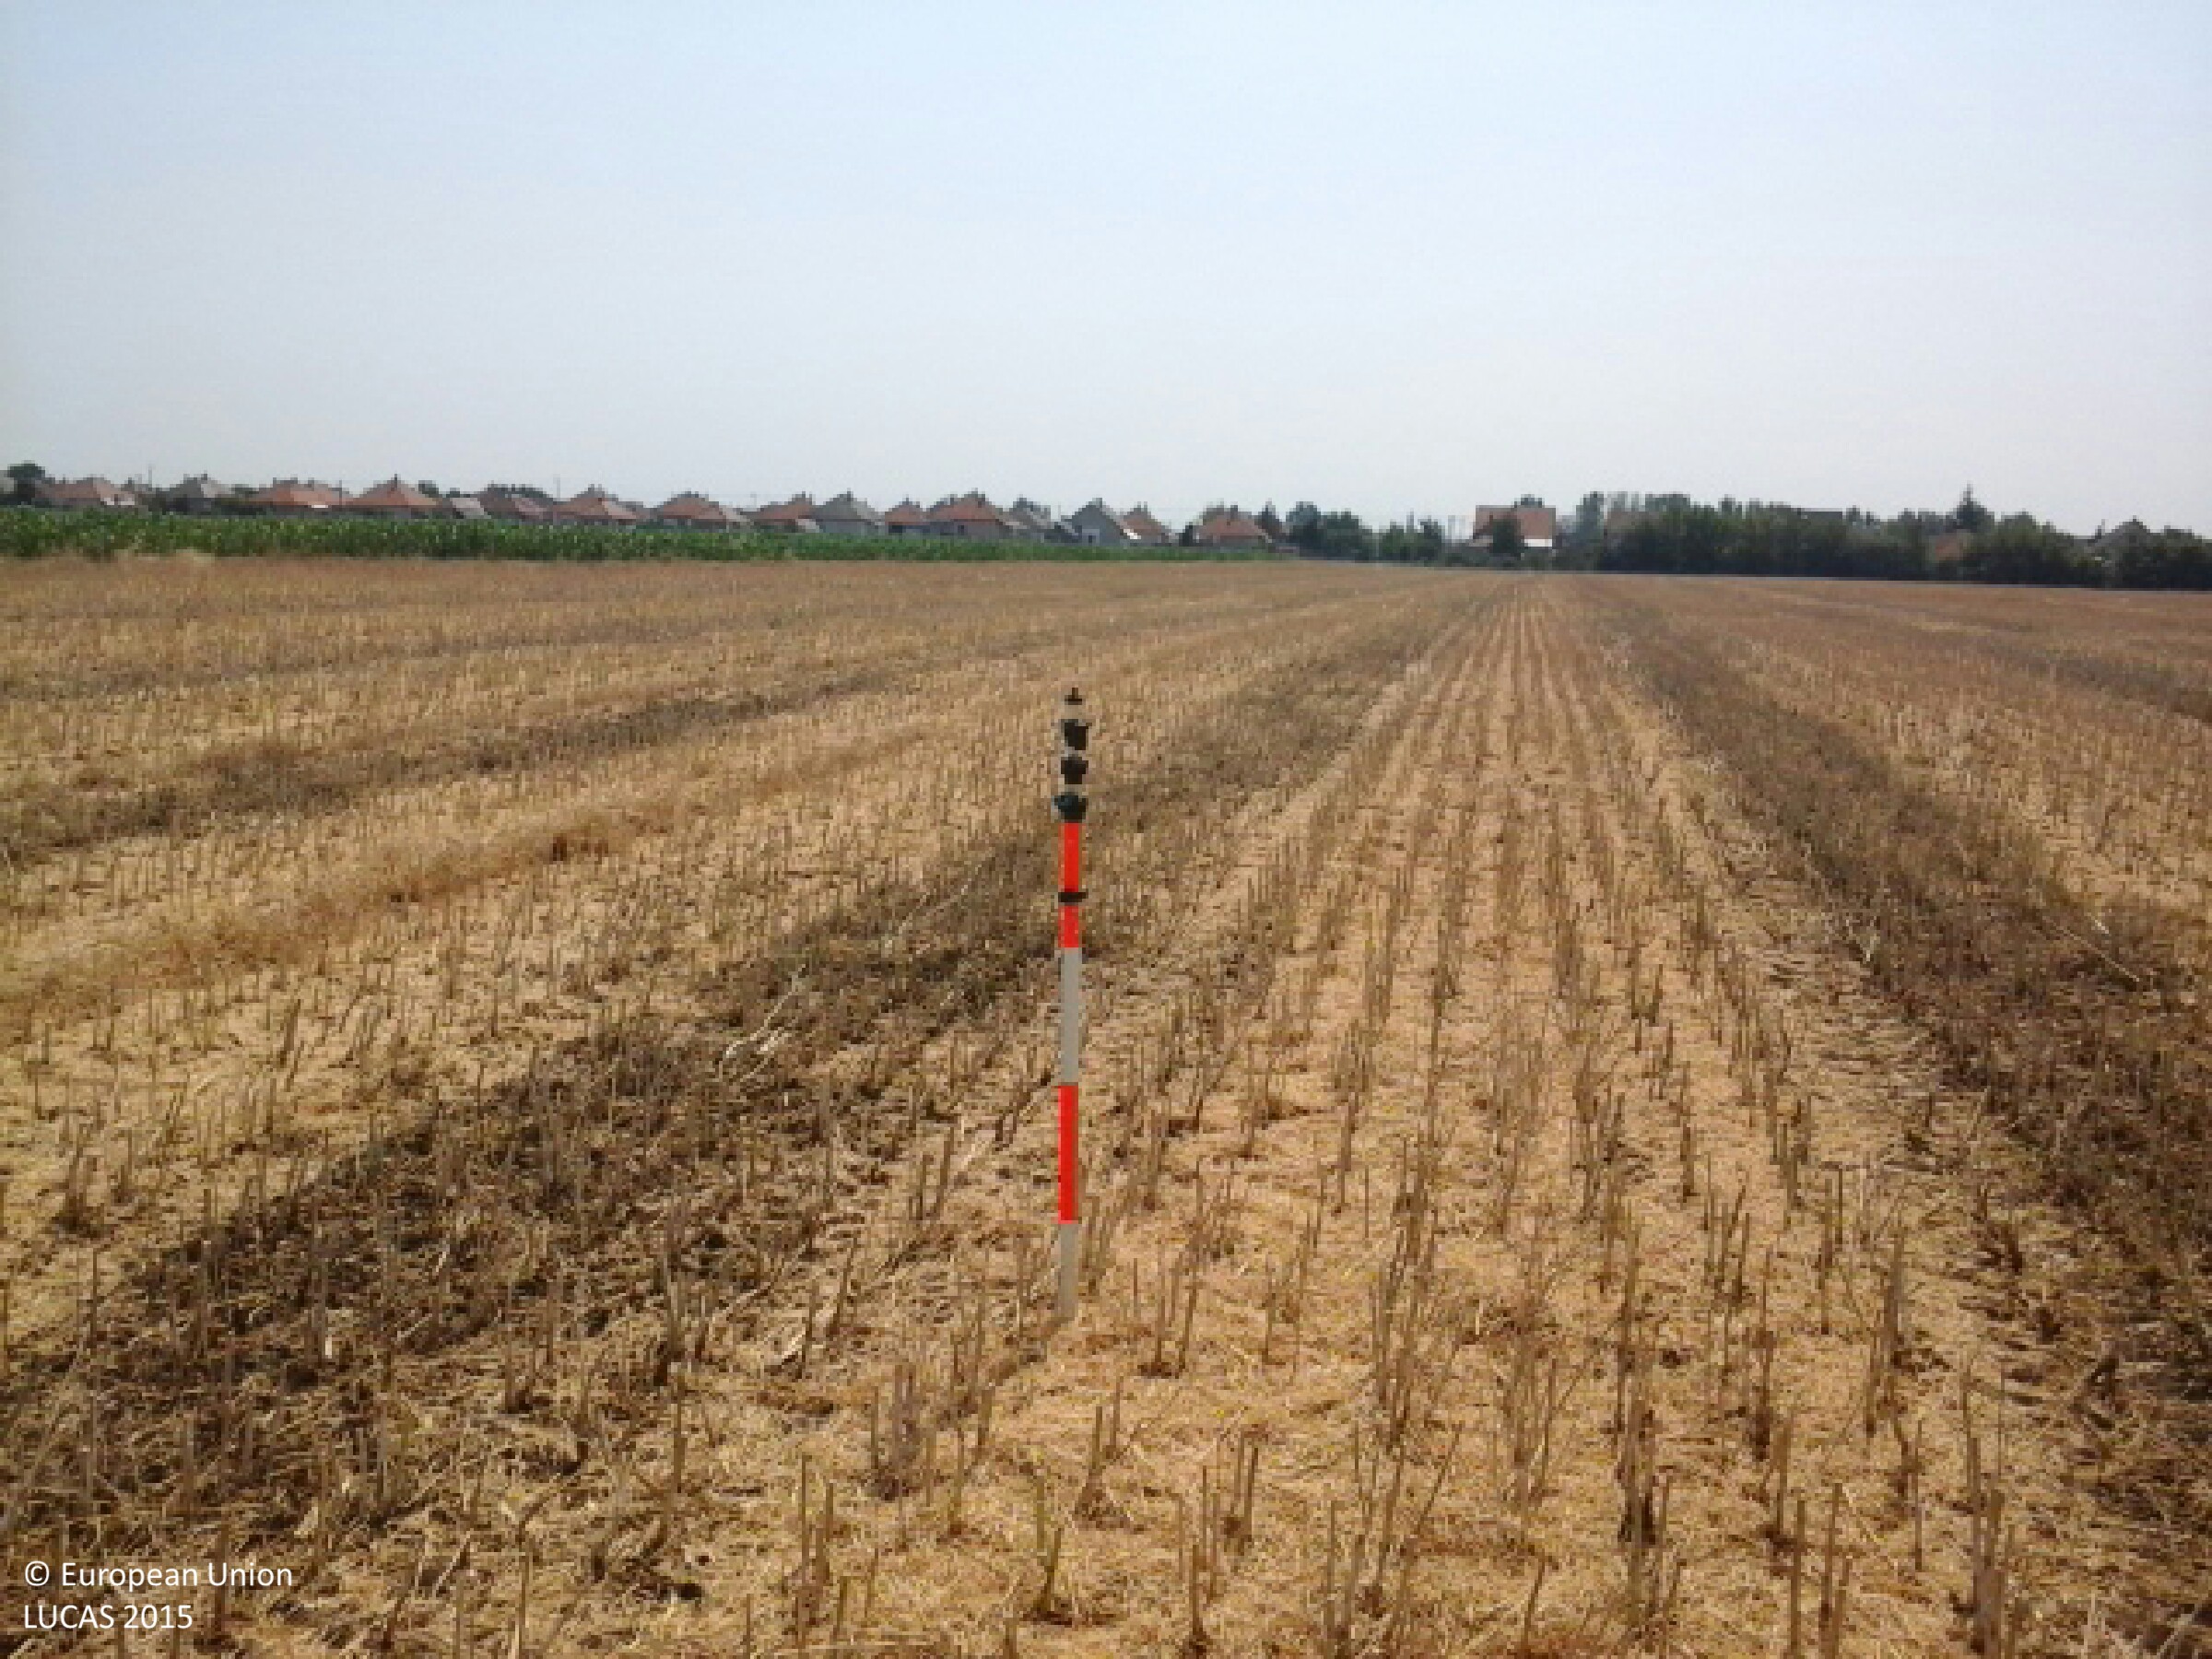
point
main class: Cropland
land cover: Rape and turnip rape
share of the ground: < 10 %
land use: Agriculture (excluding fallow land and kitchen gardens)
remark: Harvested field
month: July
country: HU
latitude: 48.0951
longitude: 21.1181
